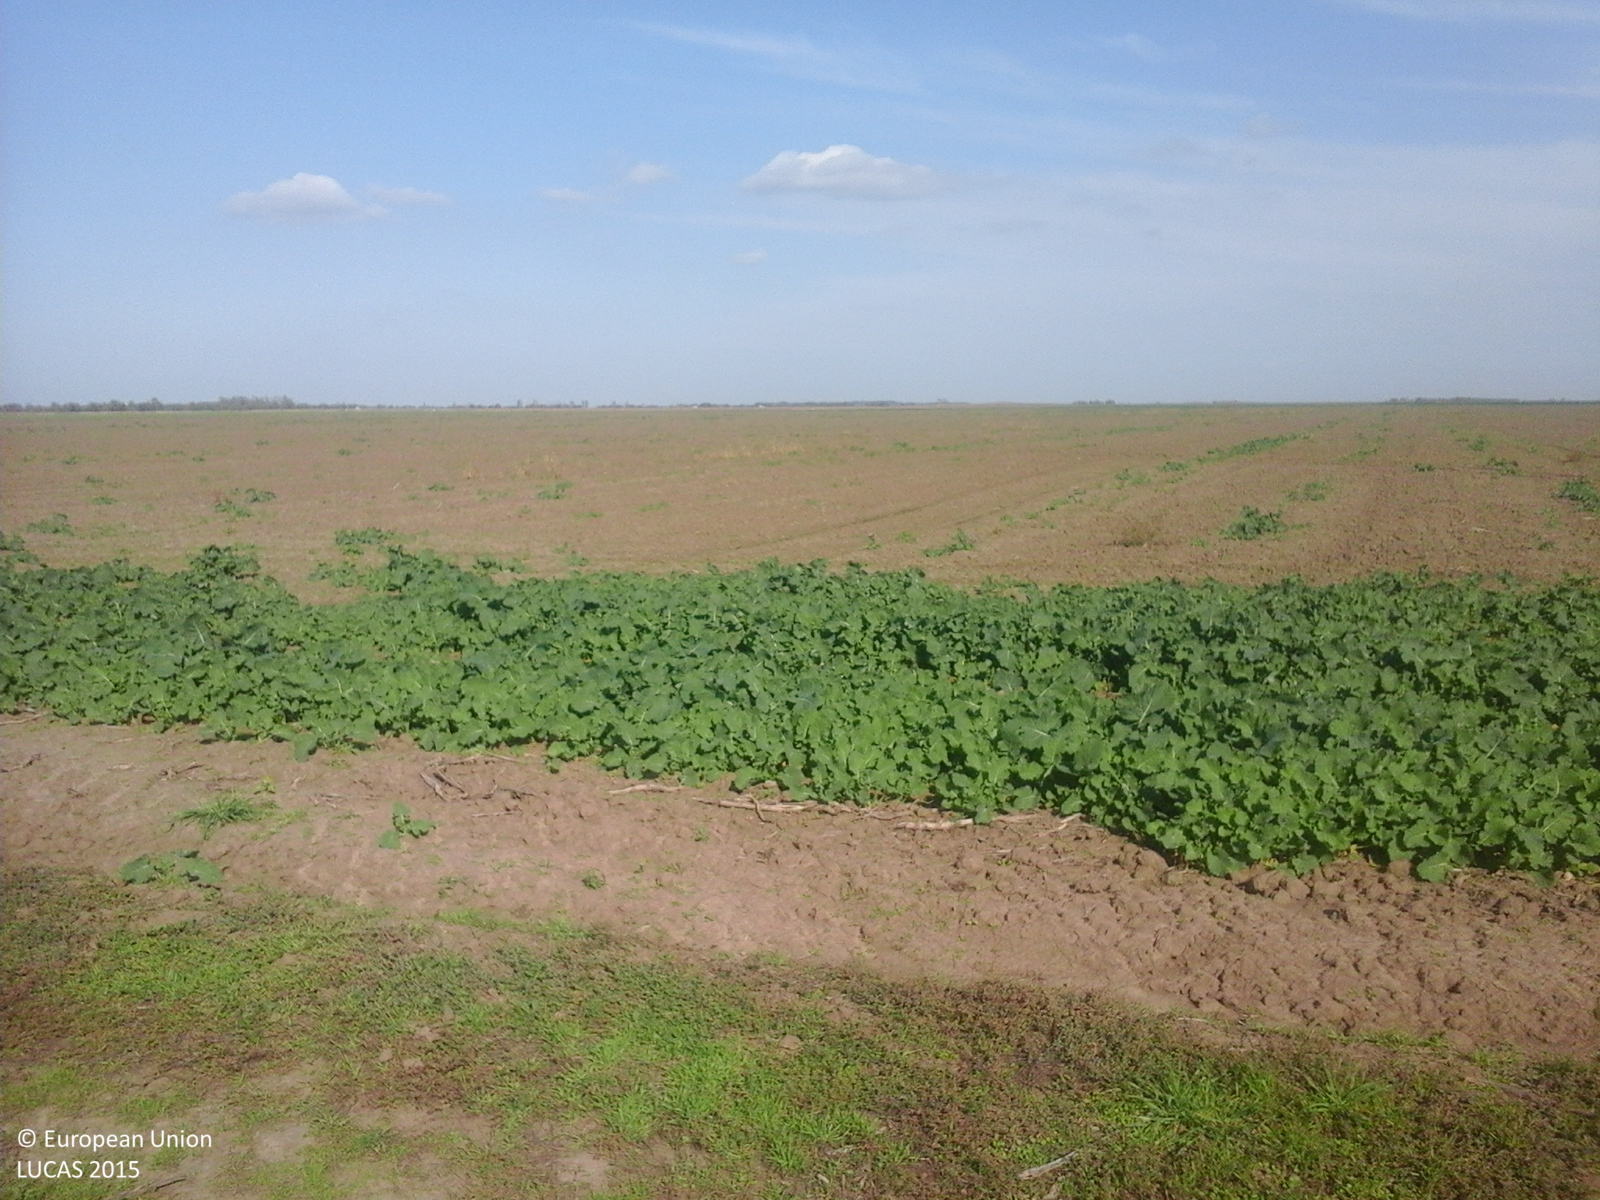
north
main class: Cropland
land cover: Common wheat
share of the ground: 25 - 50 %
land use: Agriculture (excluding fallow land and kitchen gardens)
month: October
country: RO
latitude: 45.3055
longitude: 27.3521
